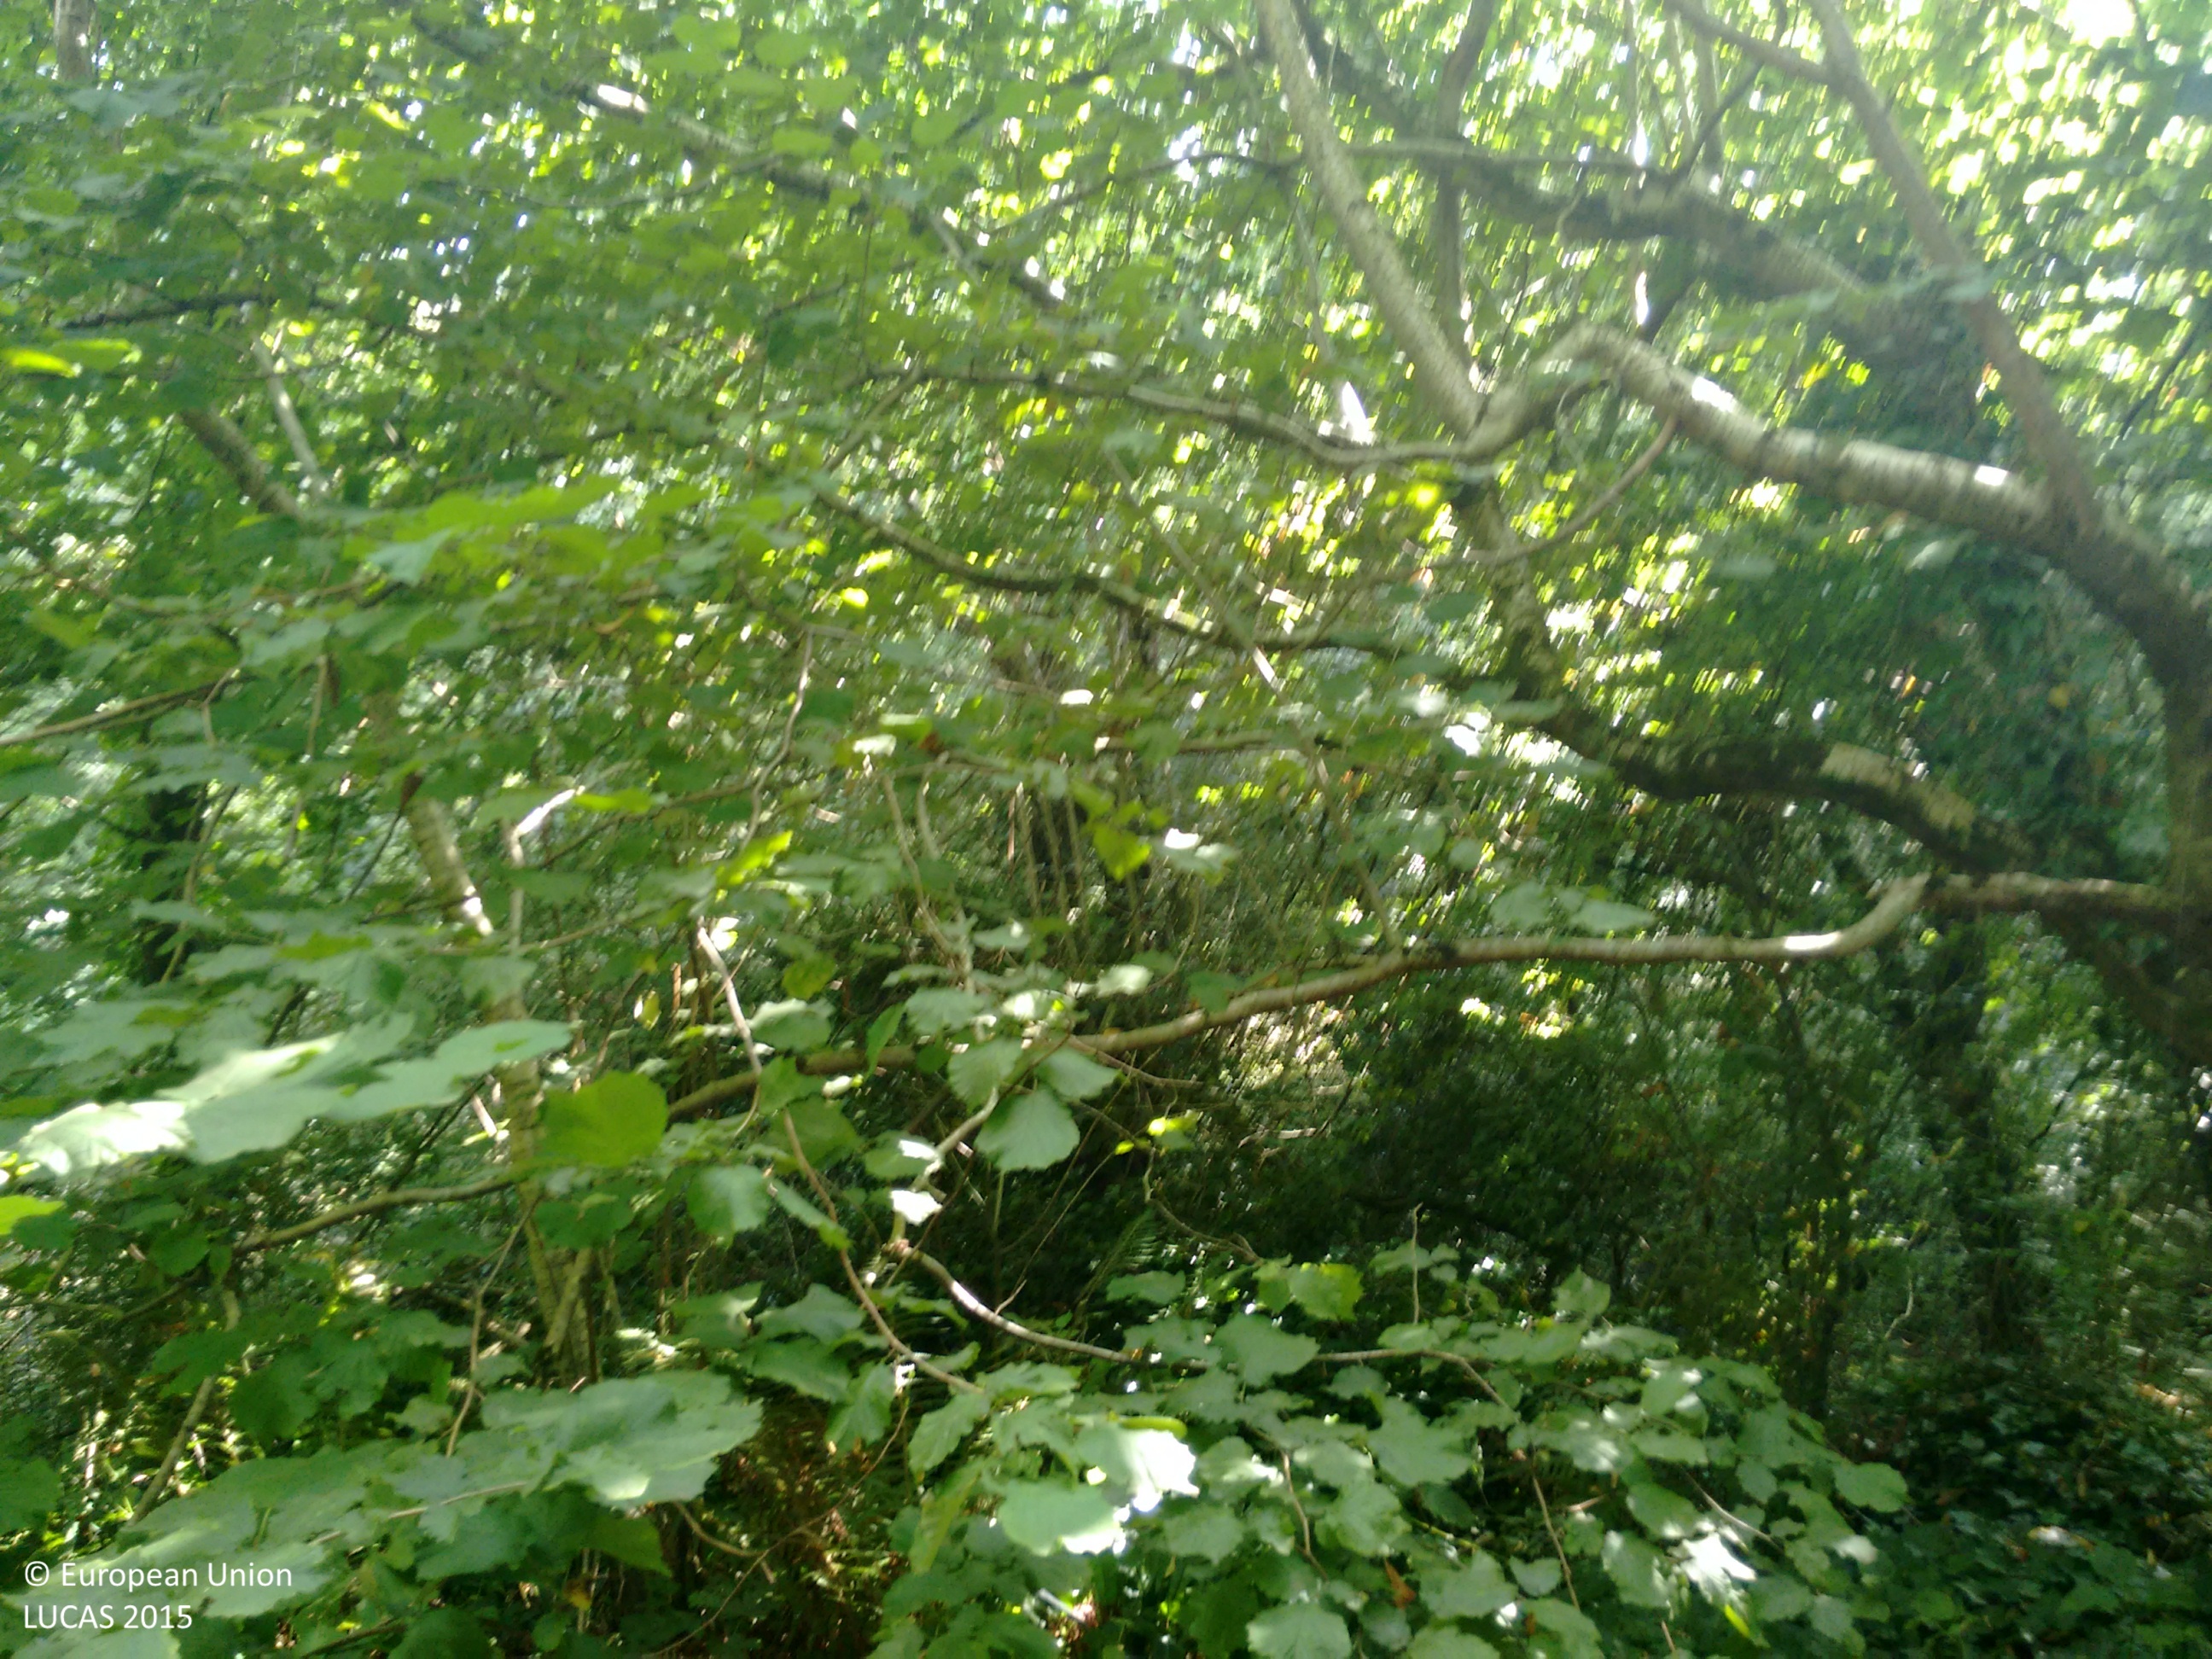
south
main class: Woodland
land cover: Broadleaved woodland
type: mesophytic deciduous forest
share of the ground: > 75 %
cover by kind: broadleaved forest trees 100 %
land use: Semi-natural and natural areas not in use
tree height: > 5 m
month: September
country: GB
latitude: 50.9580
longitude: -4.1491
